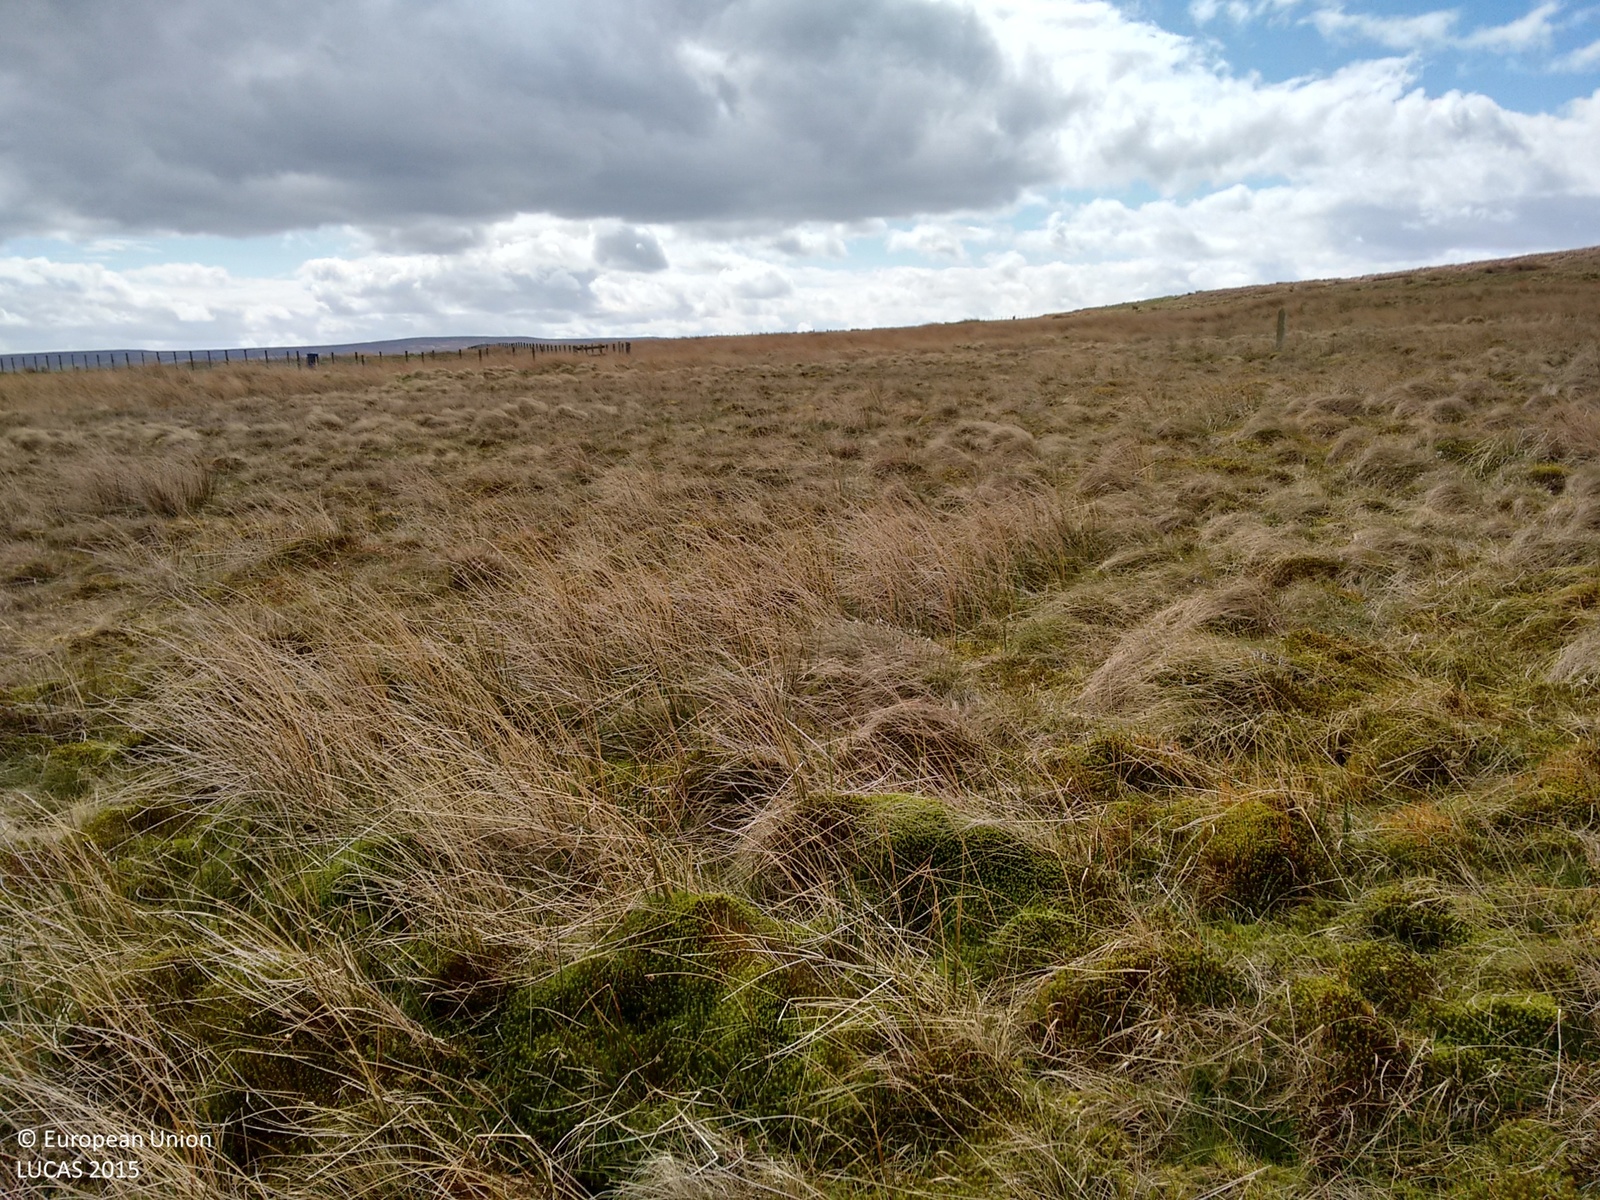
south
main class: Grassland
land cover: Grassland without tree/shrub cover
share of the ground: > 75 %
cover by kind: herbaceous plants 100 %
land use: Agriculture (excluding fallow land and kitchen gardens)
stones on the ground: < 10 %
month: May
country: GB
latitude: 54.8723
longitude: -2.0392
